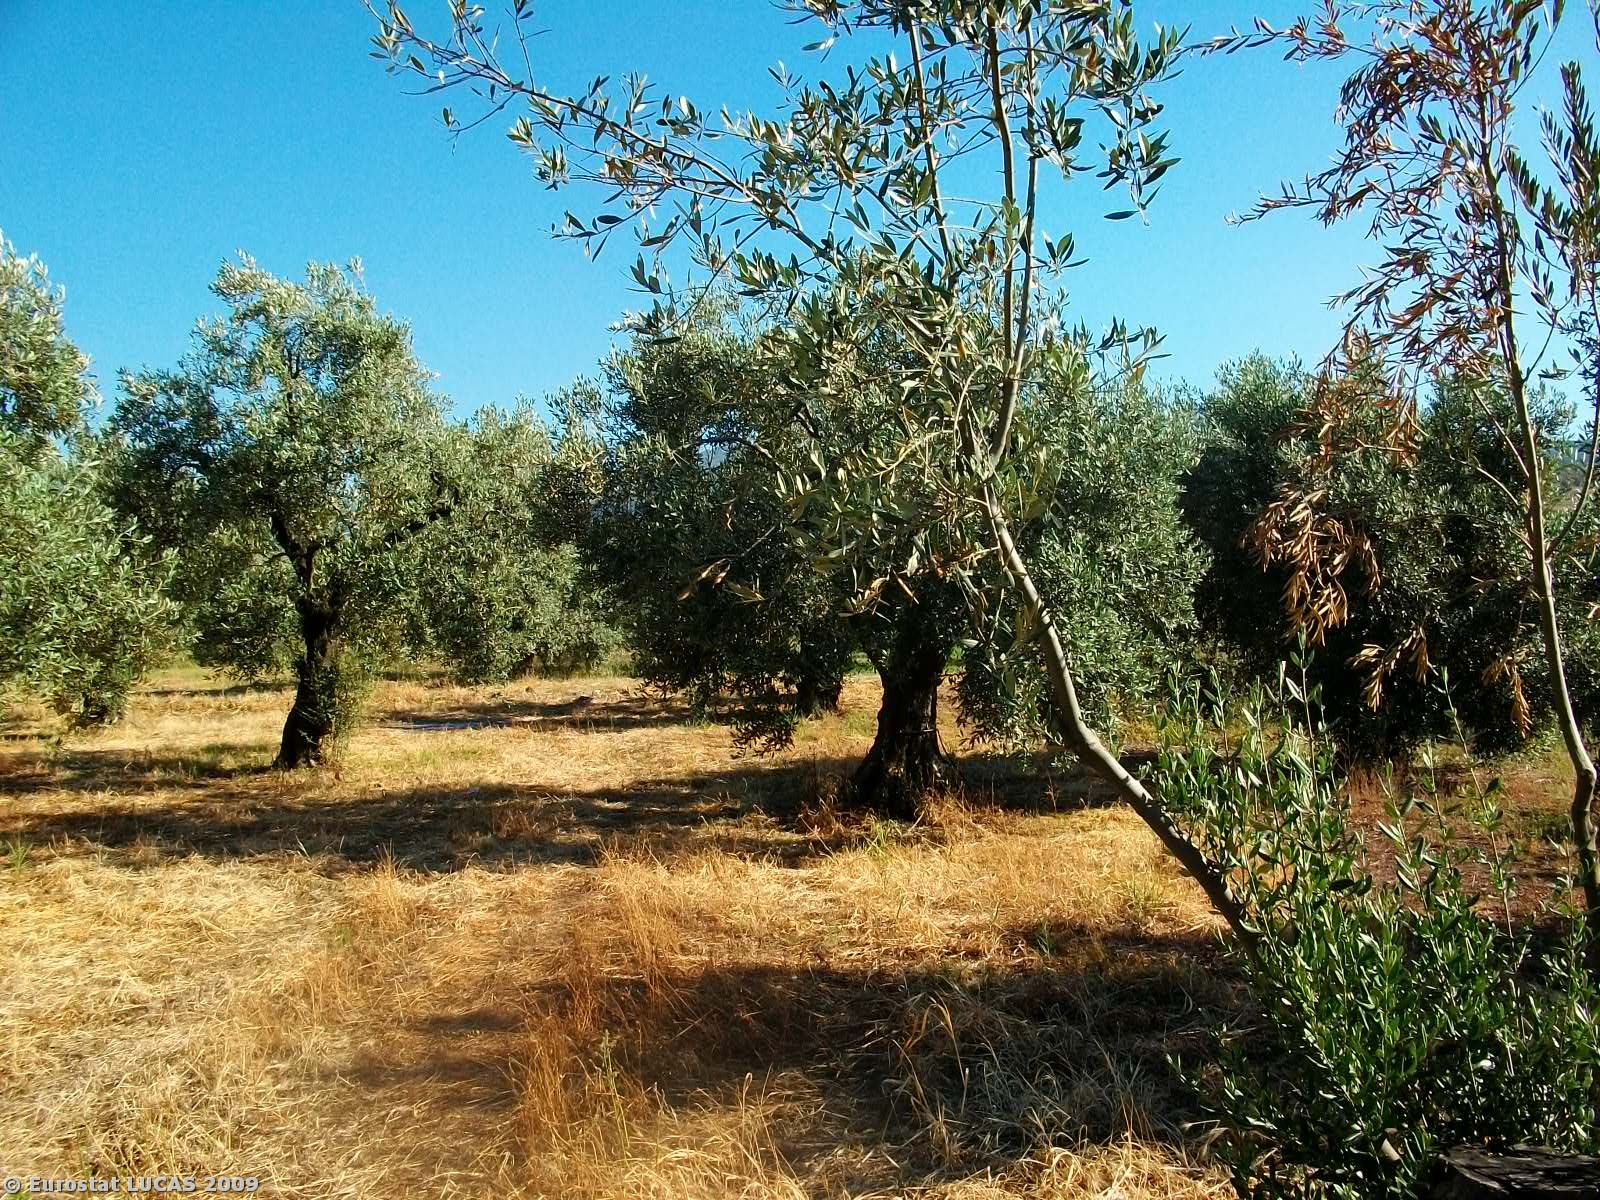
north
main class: Cropland
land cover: Olive groves
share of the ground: > 75 %
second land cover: Grassland with sparse tree/shrub cover
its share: > 75 %
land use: Agriculture (excluding fallow land and kitchen gardens)
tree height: < 5 m
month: June
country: GR
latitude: 38.8895
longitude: 22.6991
